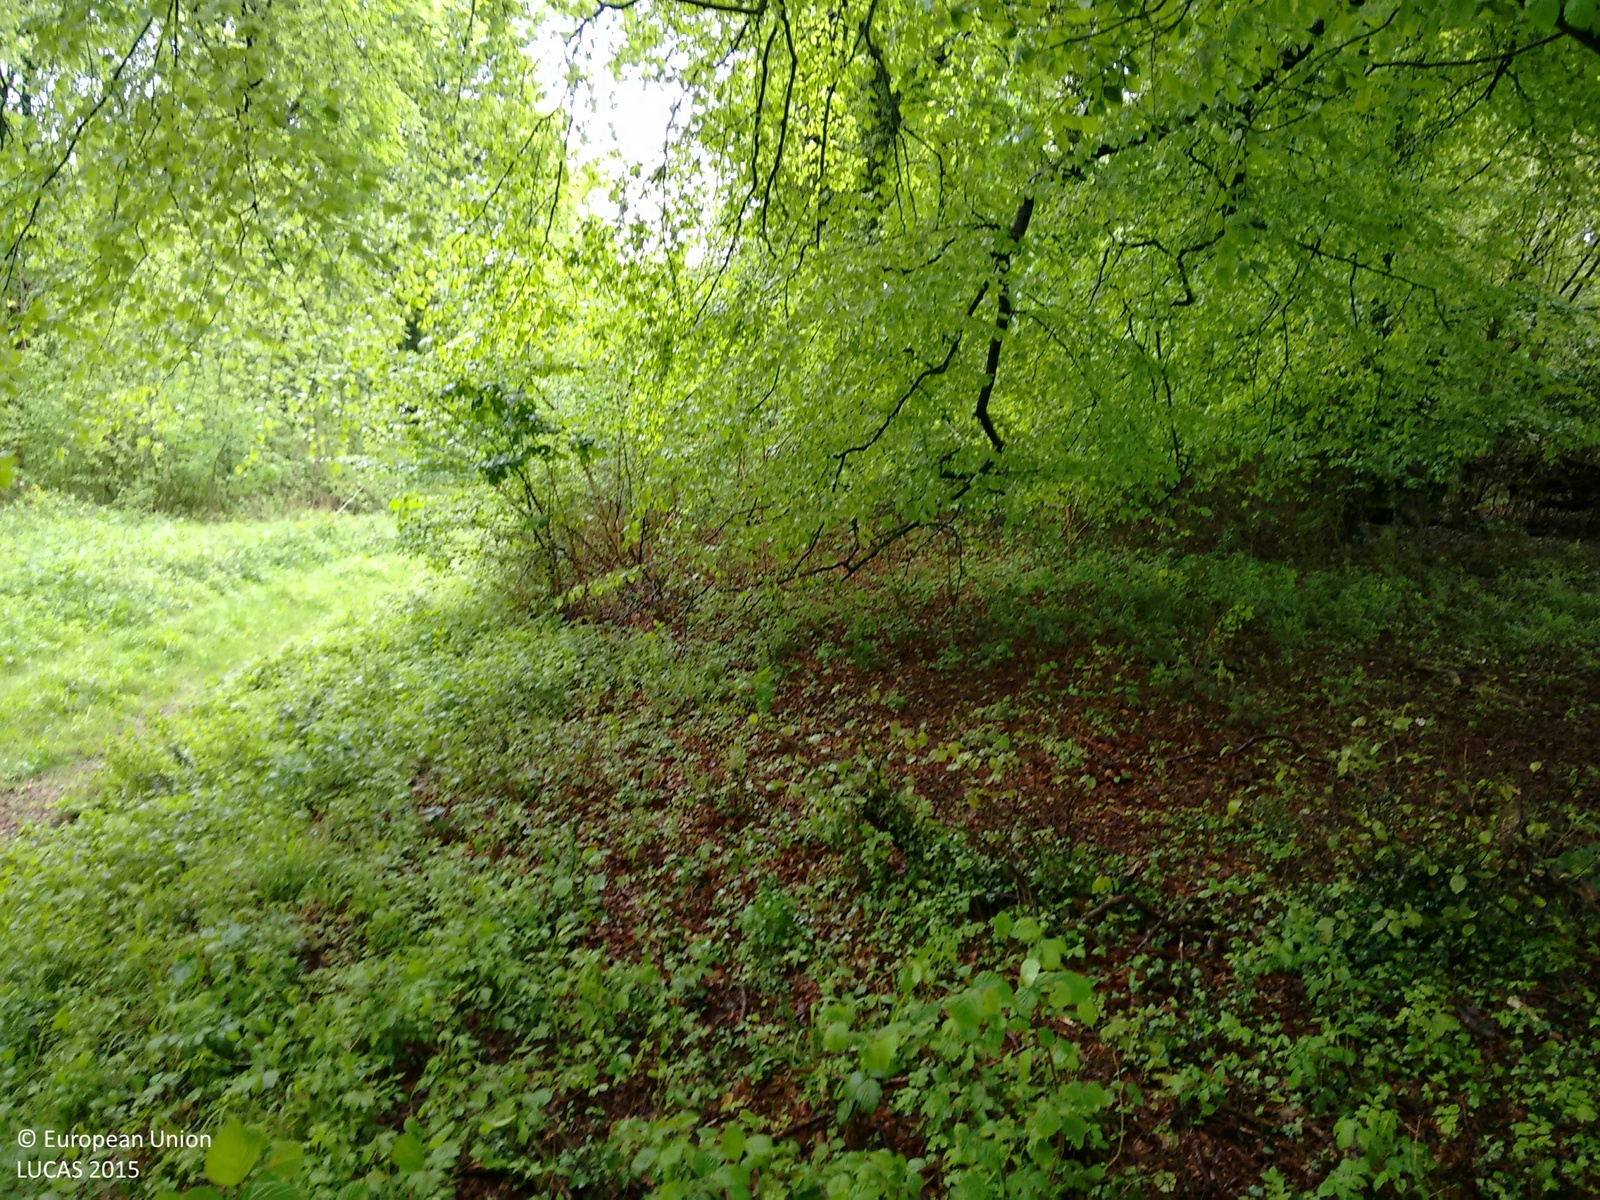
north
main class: Woodland
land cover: Broadleaved woodland
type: beech forest
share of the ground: > 75 %
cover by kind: broadleaved forest trees 100 %
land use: Semi-natural and natural areas not in use
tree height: > 5 m
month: May
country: GB
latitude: 50.9632
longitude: -0.9359
